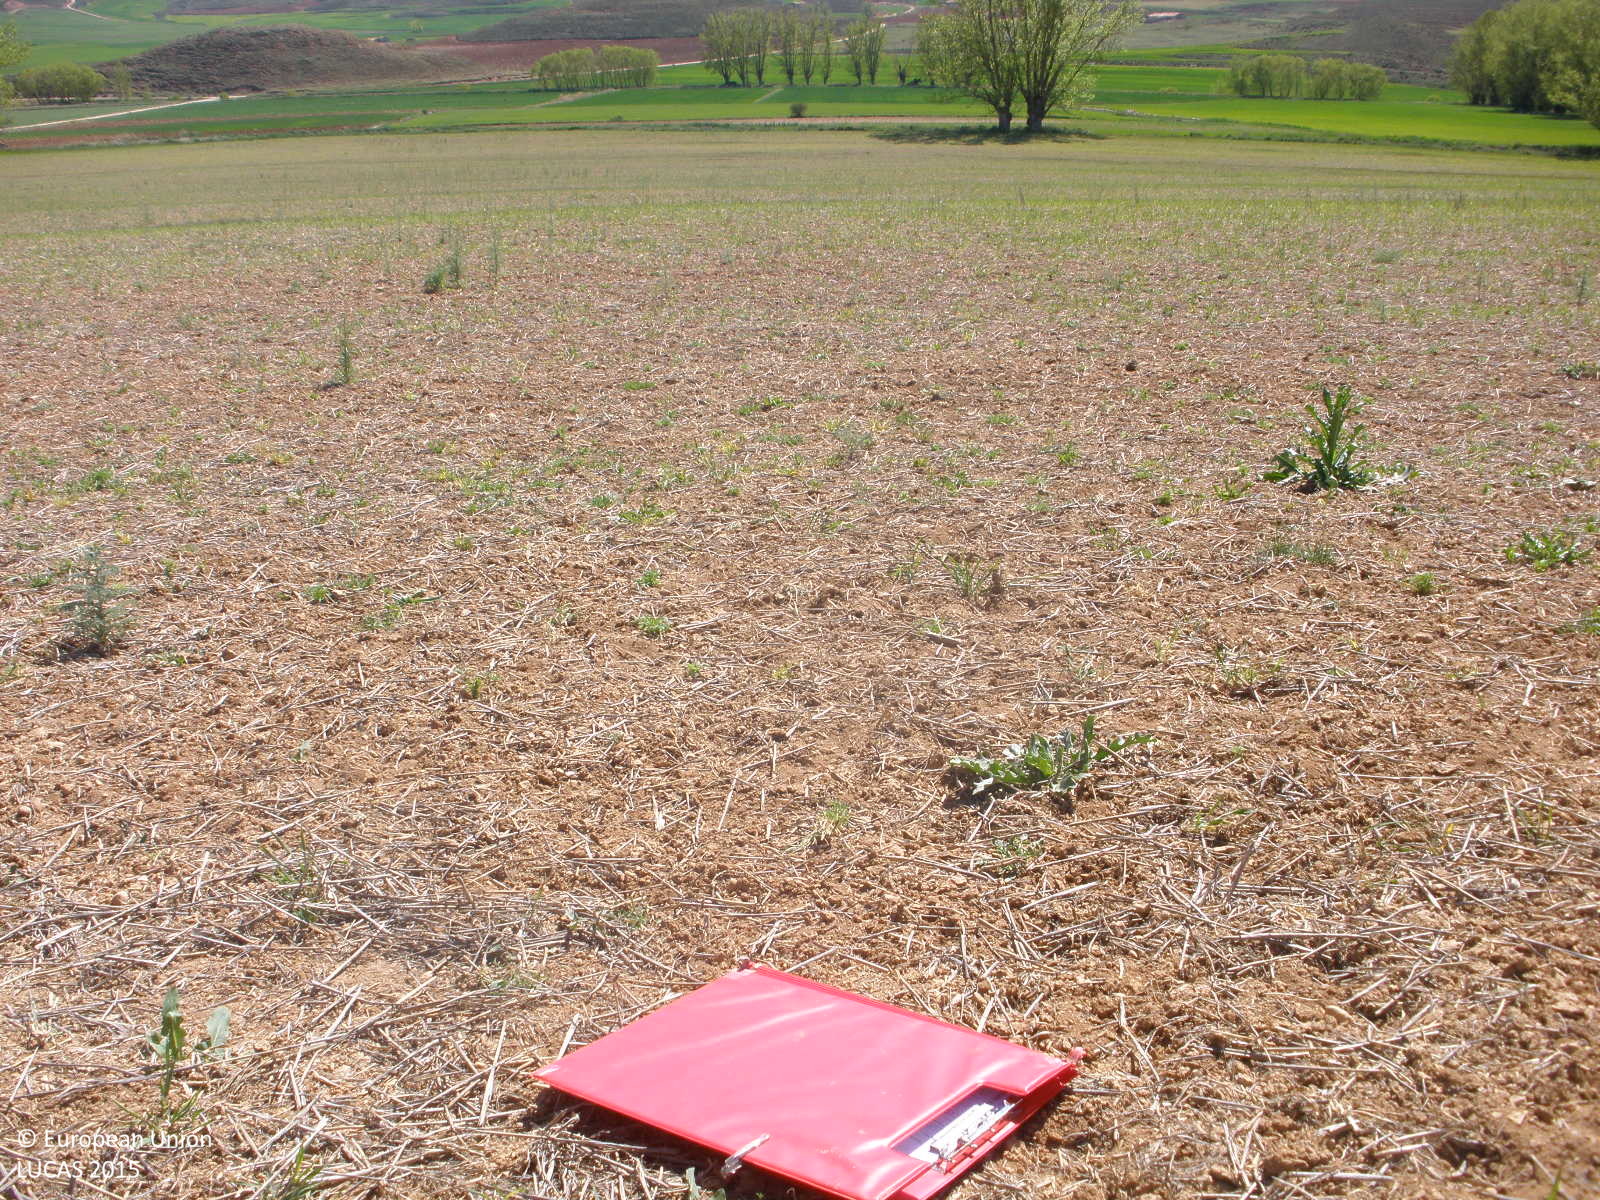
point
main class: Grassland
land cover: Spontaneously vegetated surfaces
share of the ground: 25 - 50 %
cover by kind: unconsolidated bare surface 60 %, herbaceous plants 40 %
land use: Agriculture (excluding fallow land and kitchen gardens)
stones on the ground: < 10 %
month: May
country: ES
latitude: 40.6887
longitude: -0.8157
